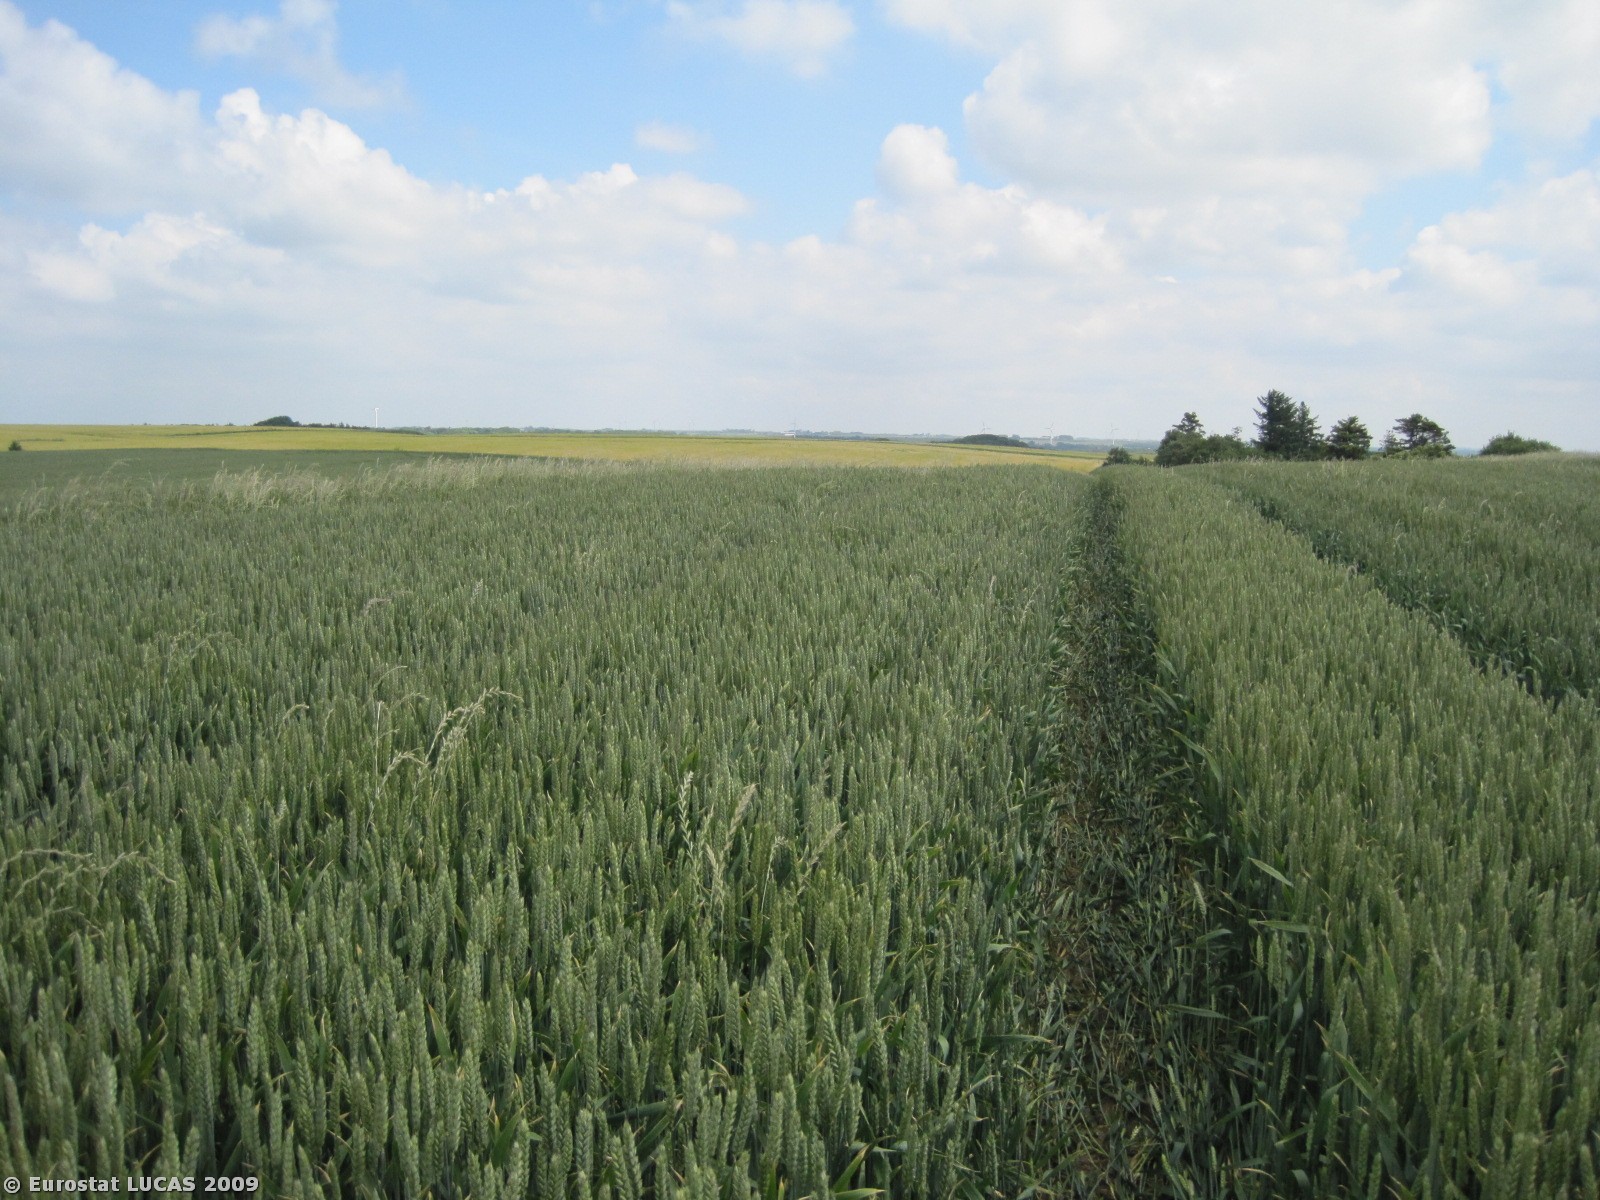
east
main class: Cropland
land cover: Common wheat
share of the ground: > 75 %
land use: Agriculture (excluding fallow land and kitchen gardens)
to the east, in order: Common wheat; Grassland without tree/shrub cover; Barley; Grassland without tree/shrub cover; Maize; Grassland without tree/shrub cover; Broadleaved woodland; Grassland without tree/shrub cover
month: June
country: DK
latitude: 56.5775
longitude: 8.7807
